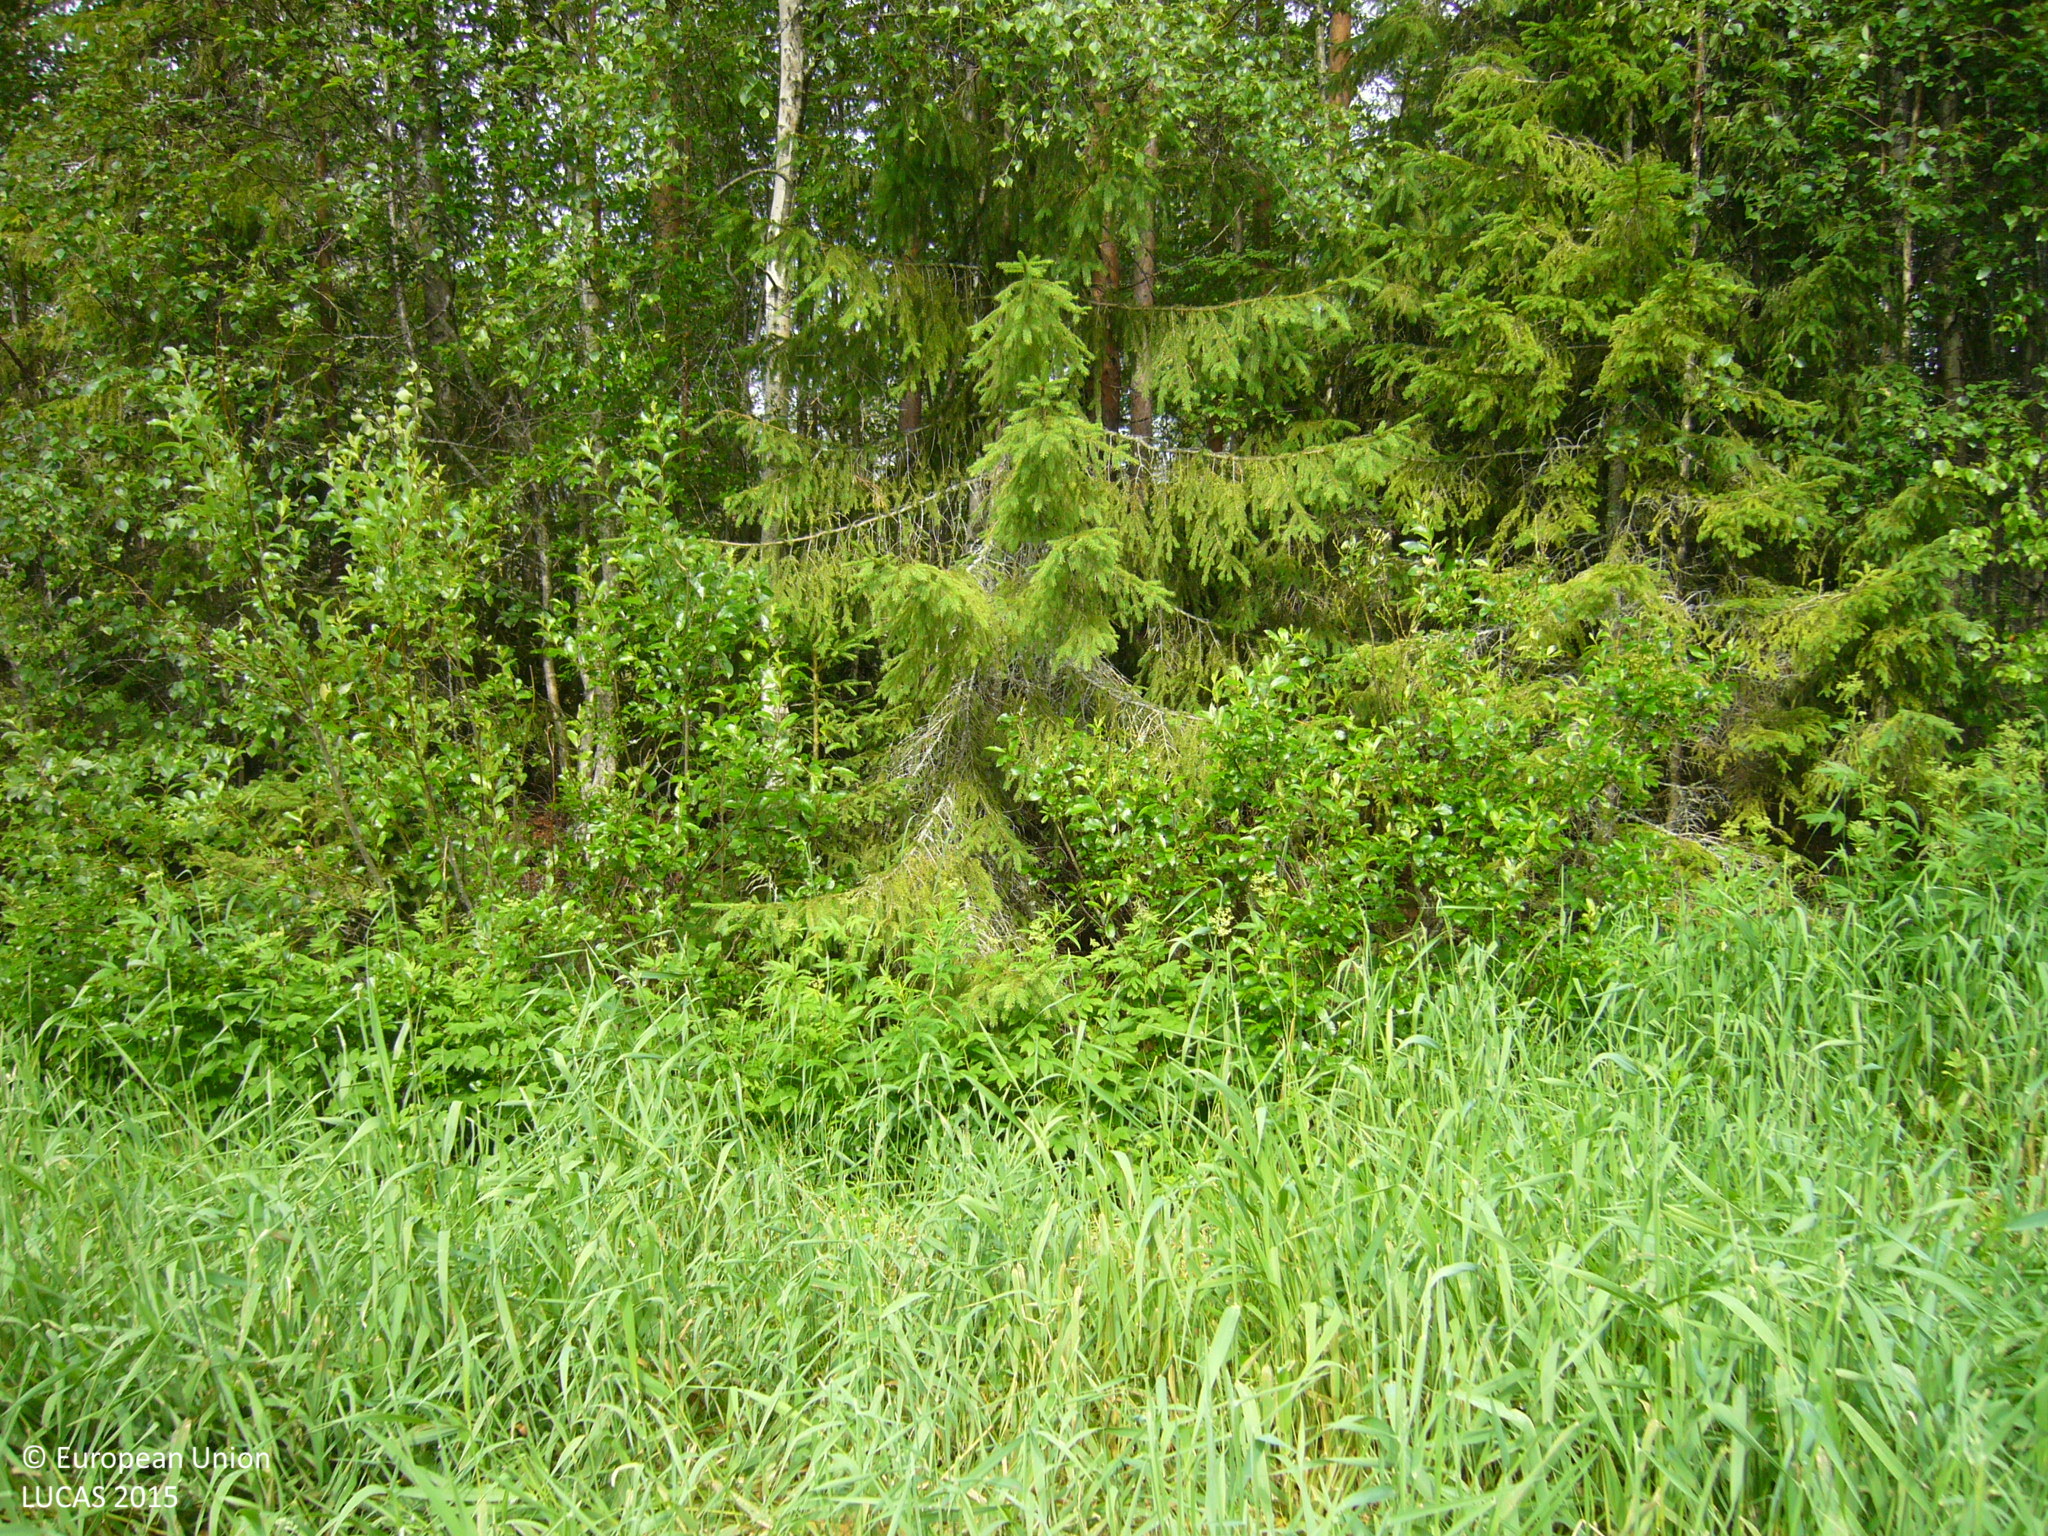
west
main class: Cropland
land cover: Temporary grasslands
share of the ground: > 75 %
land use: Agriculture (excluding fallow land and kitchen gardens)
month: July
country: FI
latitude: 63.5091
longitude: 25.5962
